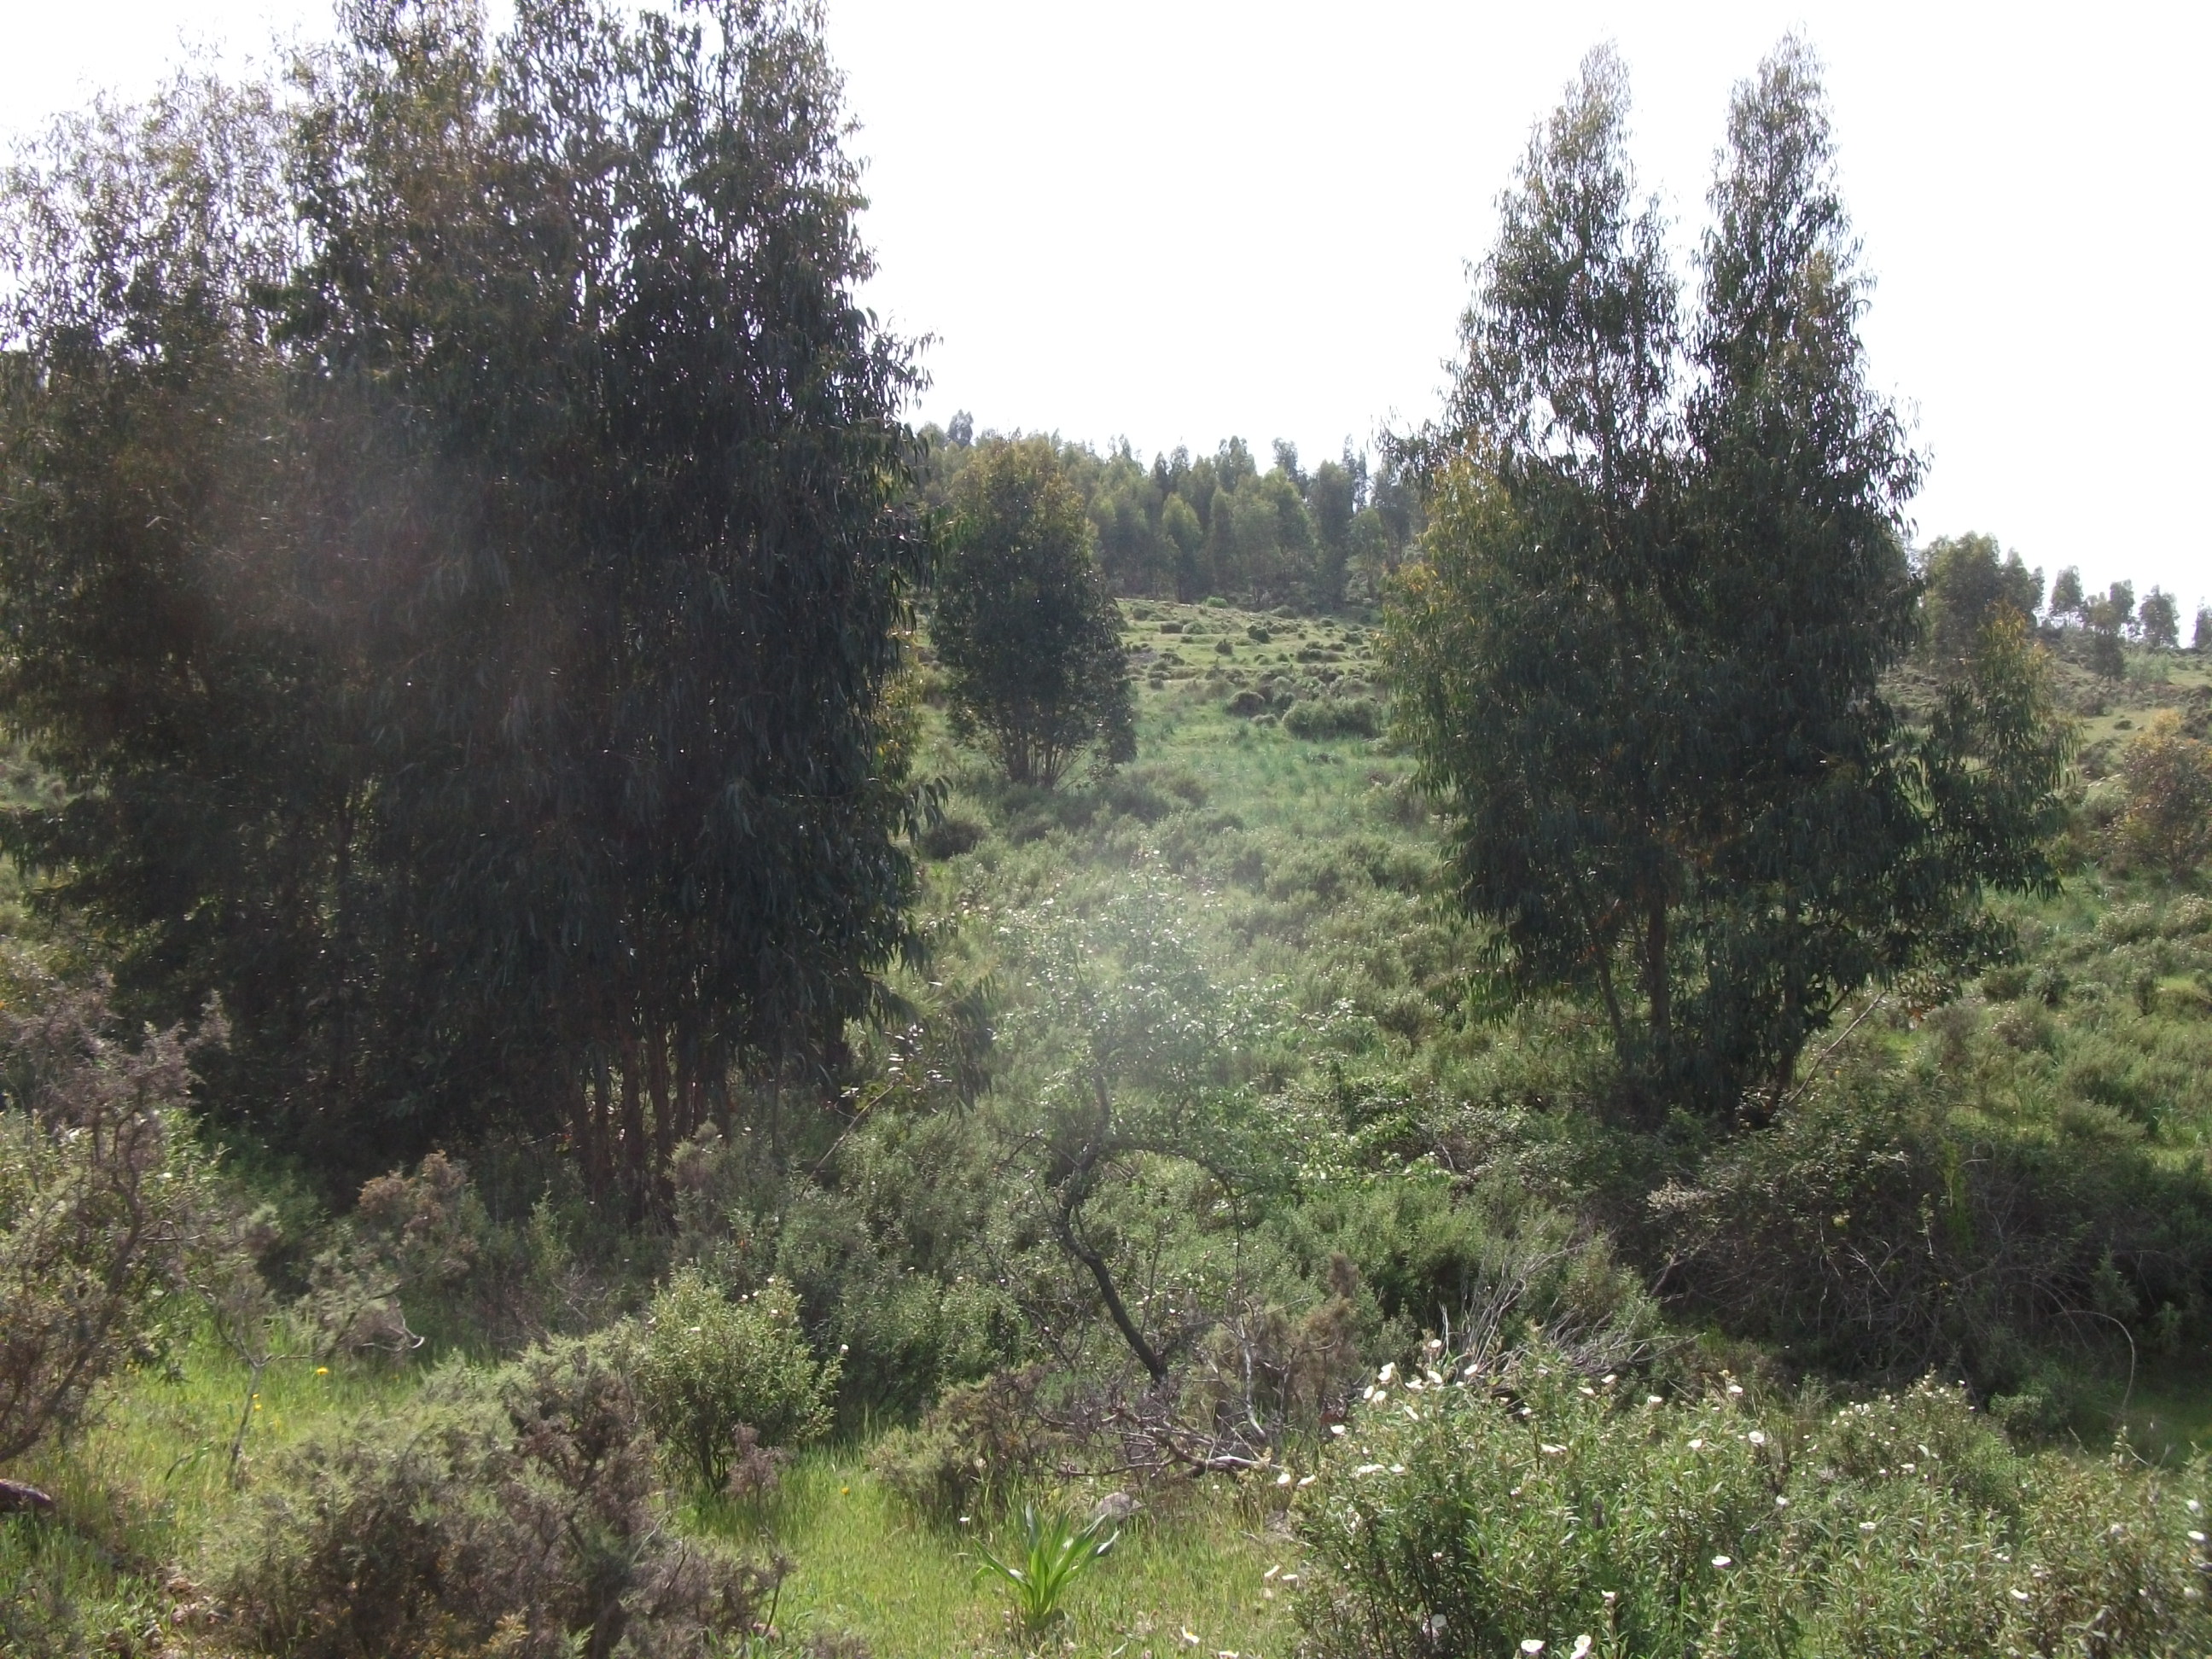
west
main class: Shrubland
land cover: Shrubland with sparse tree cover
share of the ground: > 75 %
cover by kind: shrubs 80 %, herbaceous plants 15 %, broadleaved forest trees 5 %
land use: Agriculture (excluding fallow land and kitchen gardens)
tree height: > 5 m
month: April
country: ES
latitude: 37.8049
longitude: -6.7296
